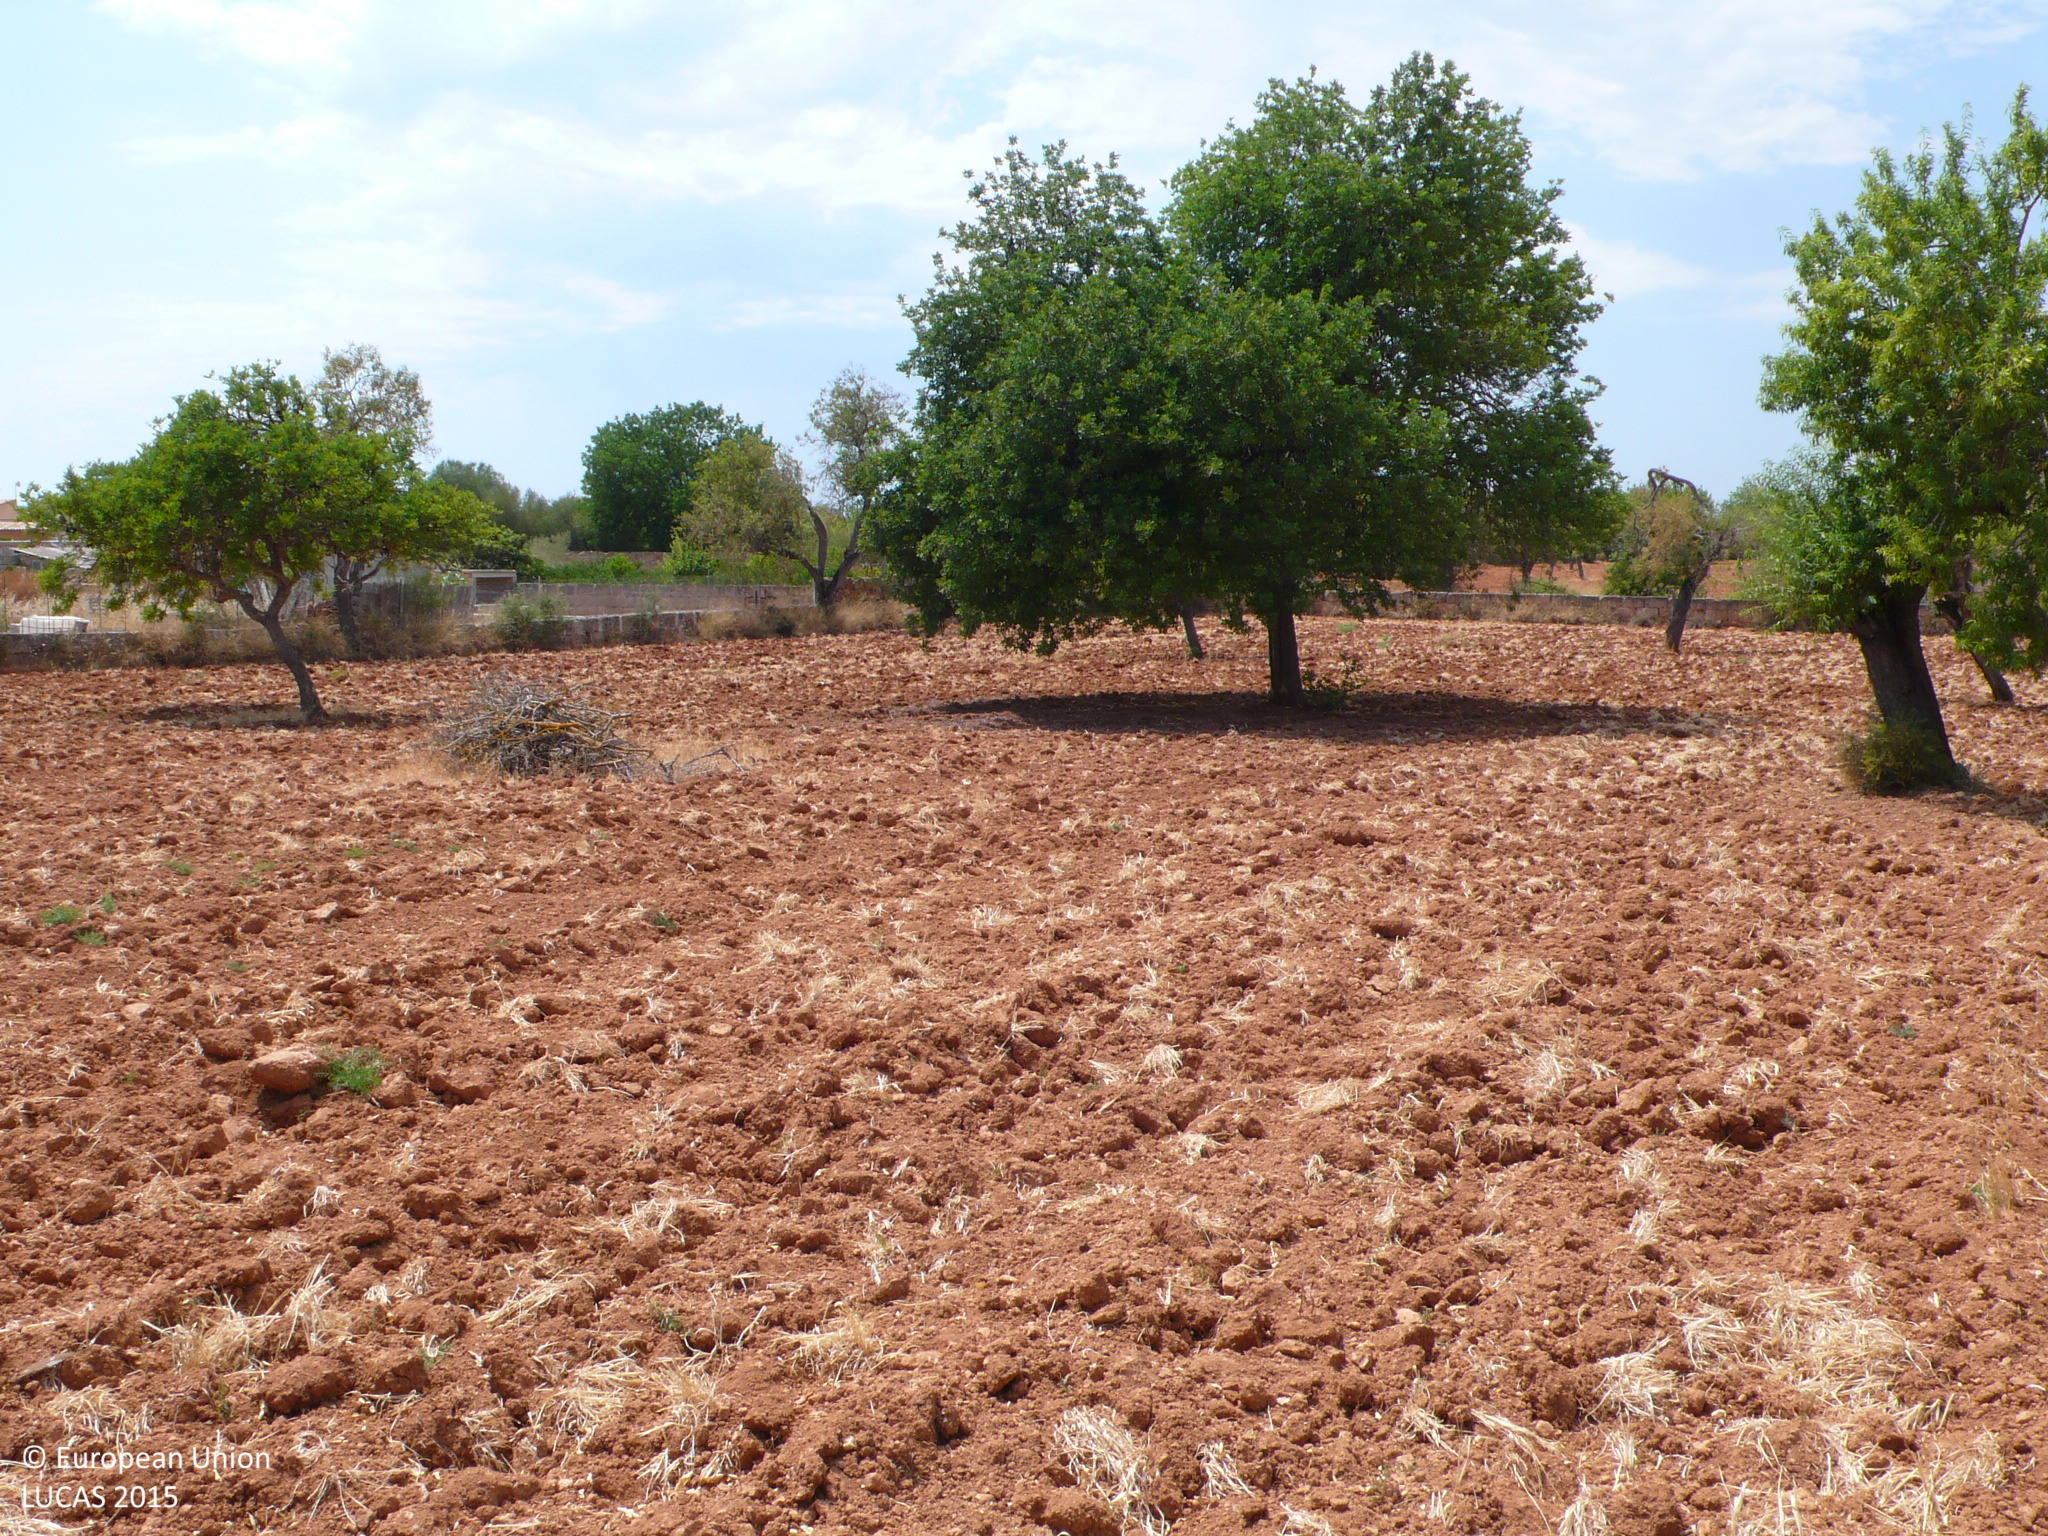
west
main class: Cropland
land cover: Nuts trees
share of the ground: 10 - 25 %
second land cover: Other bare soil
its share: > 75 %
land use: Agriculture (excluding fallow land and kitchen gardens)
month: July
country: ES
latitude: 39.4472
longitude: 2.9080
